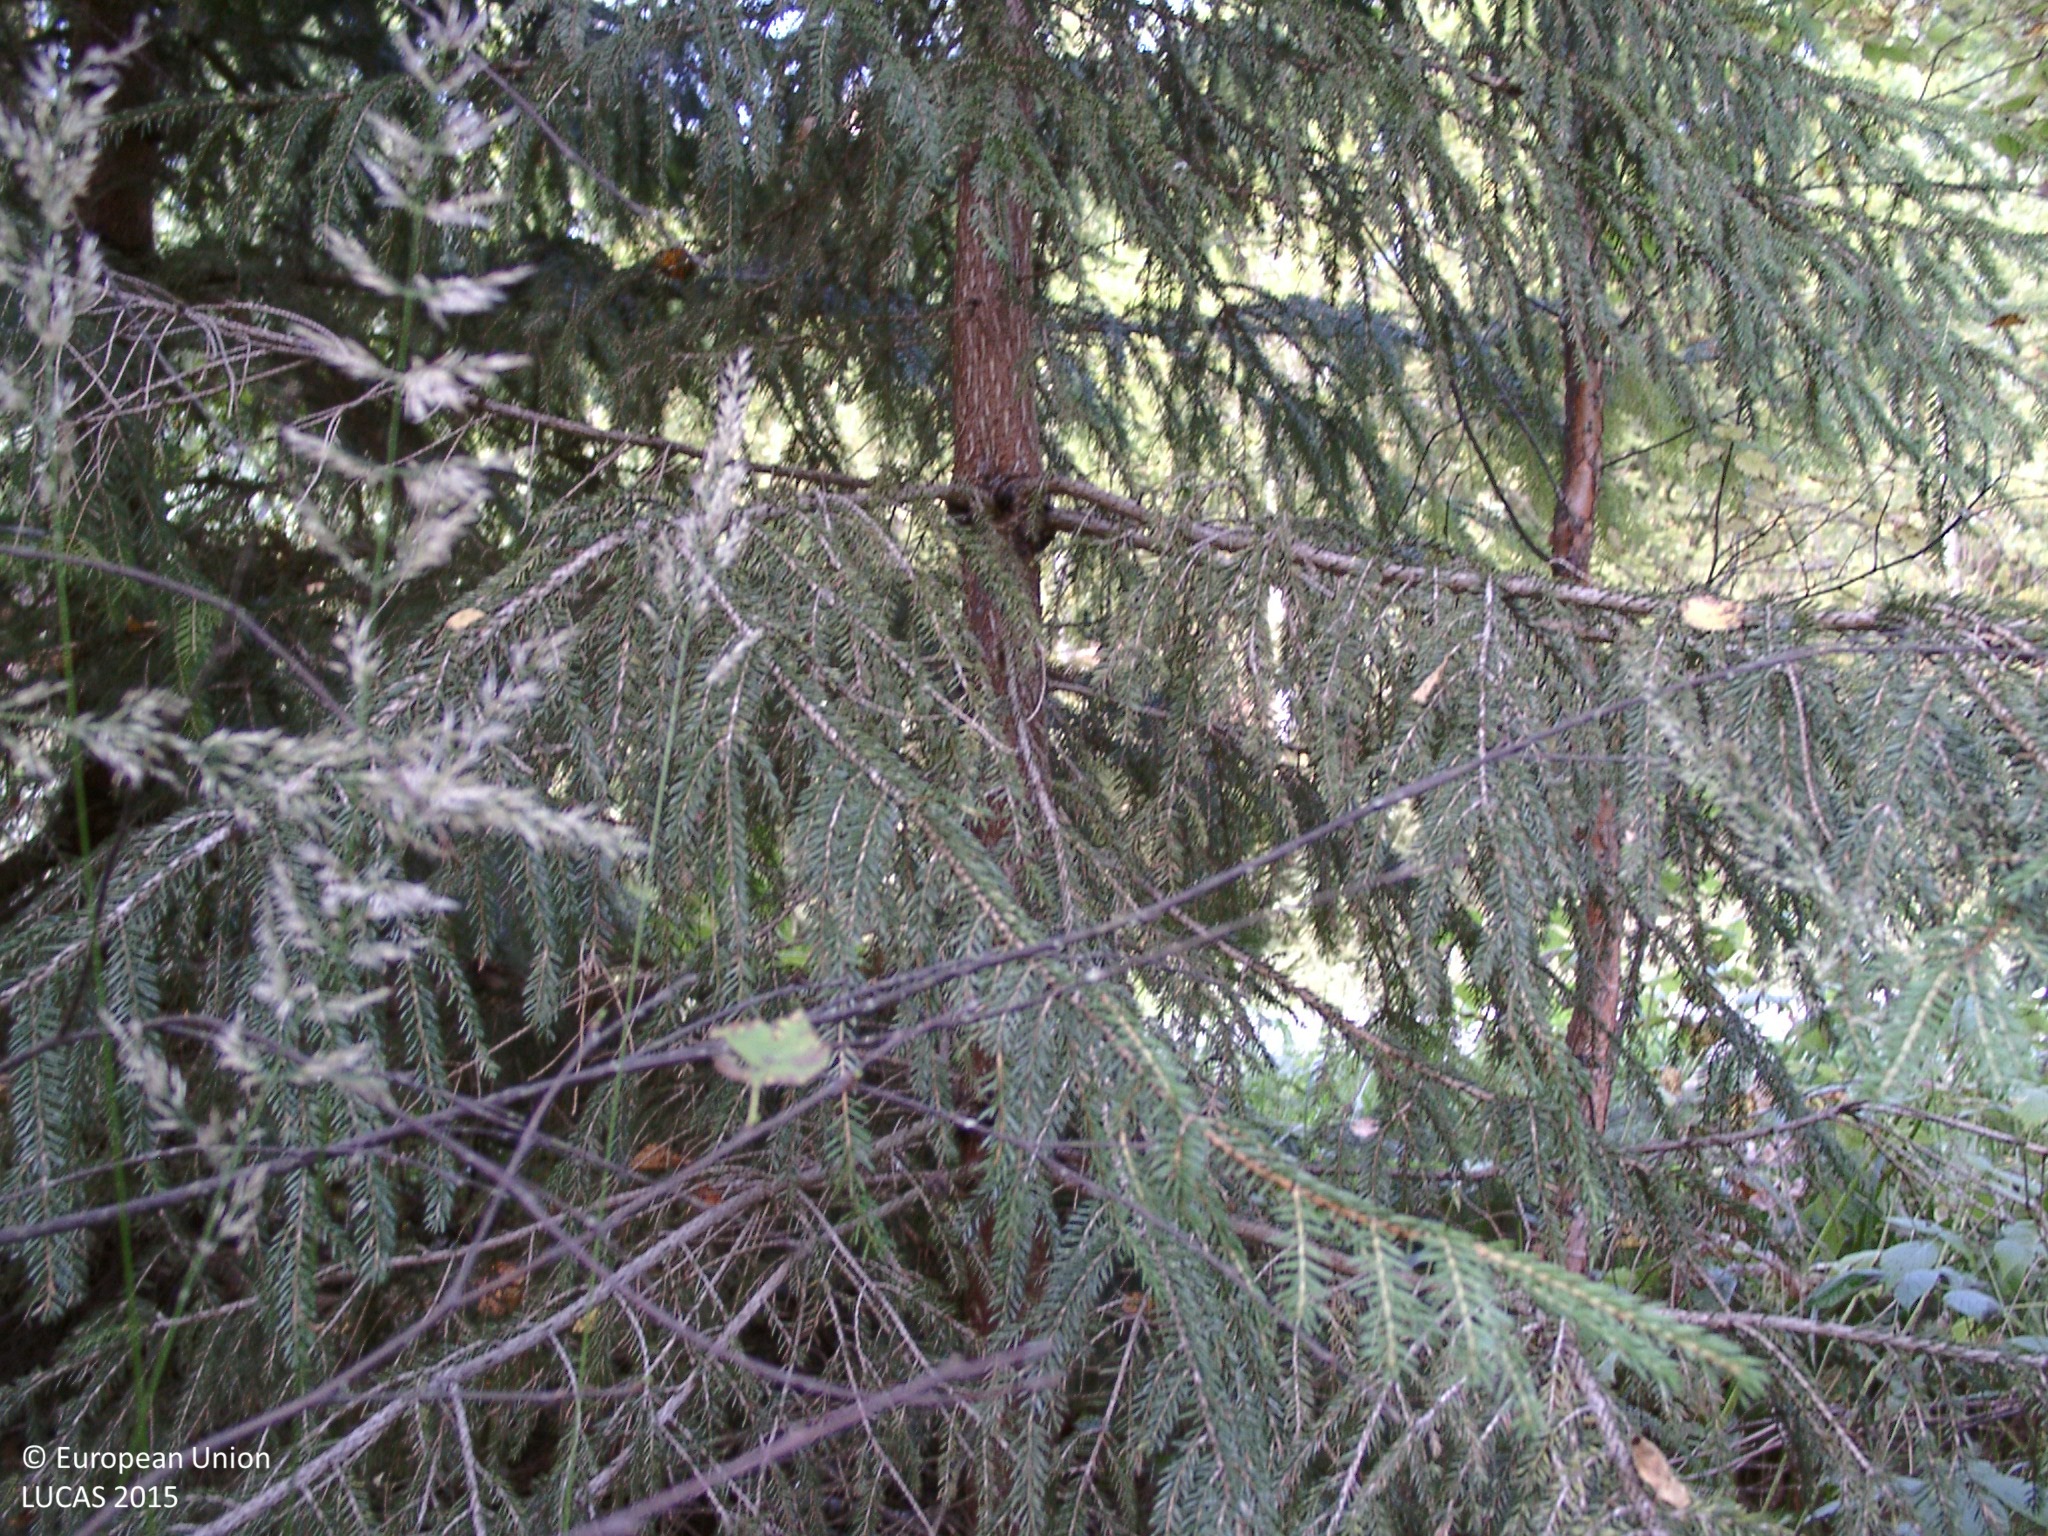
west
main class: Woodland
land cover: Broadleaved woodland
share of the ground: 50 - 75 %
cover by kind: broadleaved forest trees 55 %, herbaceous plants 20 %, shrubs 15 %, coniferous forest trees 10 %
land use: Forestry
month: August
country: FI
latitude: 61.8057
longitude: 25.1171
